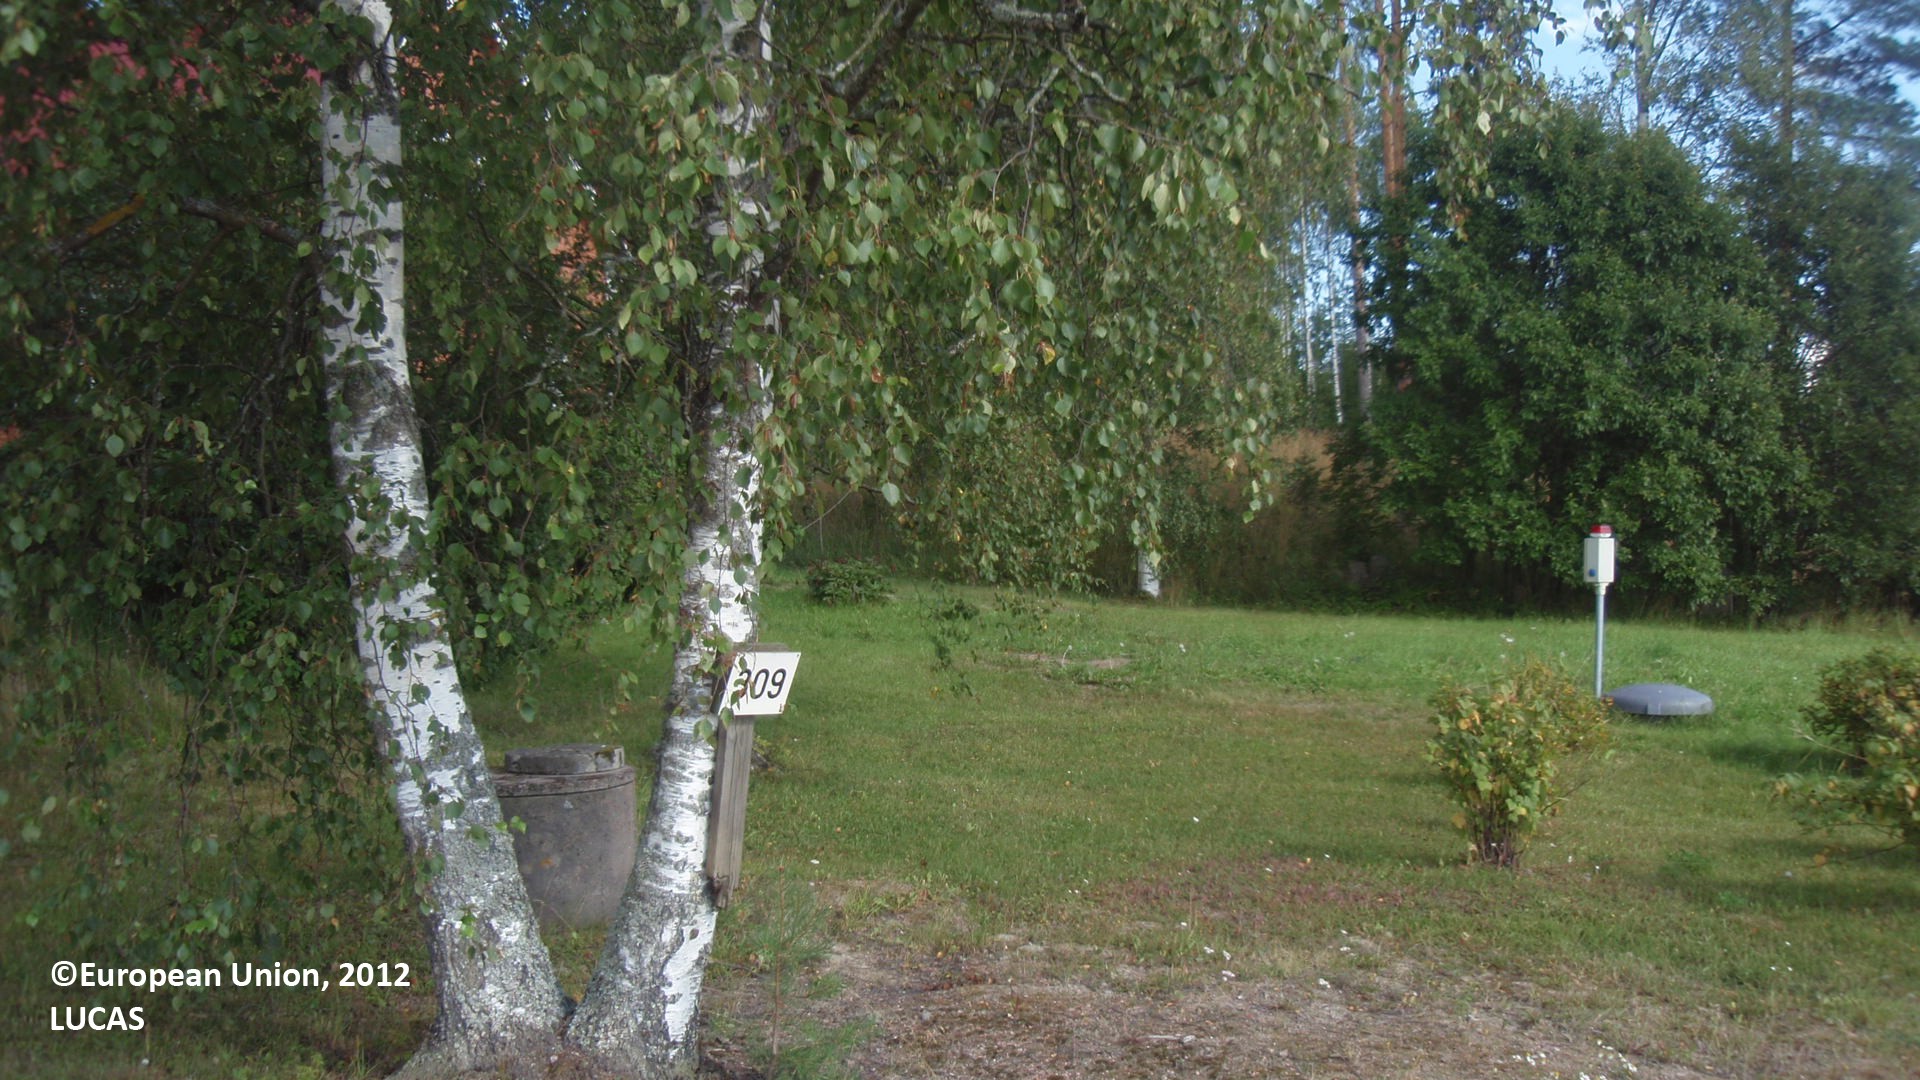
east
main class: Cropland
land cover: Rye
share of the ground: > 75 %
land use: Agriculture (excluding fallow land and kitchen gardens)
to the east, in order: Rye; Grassland with sparse tree/shrub cover; Paved roads, cycling and walking lanes; Grassland with sparse tree/shrub cover; Spruce dominated mixed woodland
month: August
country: FI
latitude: 61.0110
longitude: 26.7891
